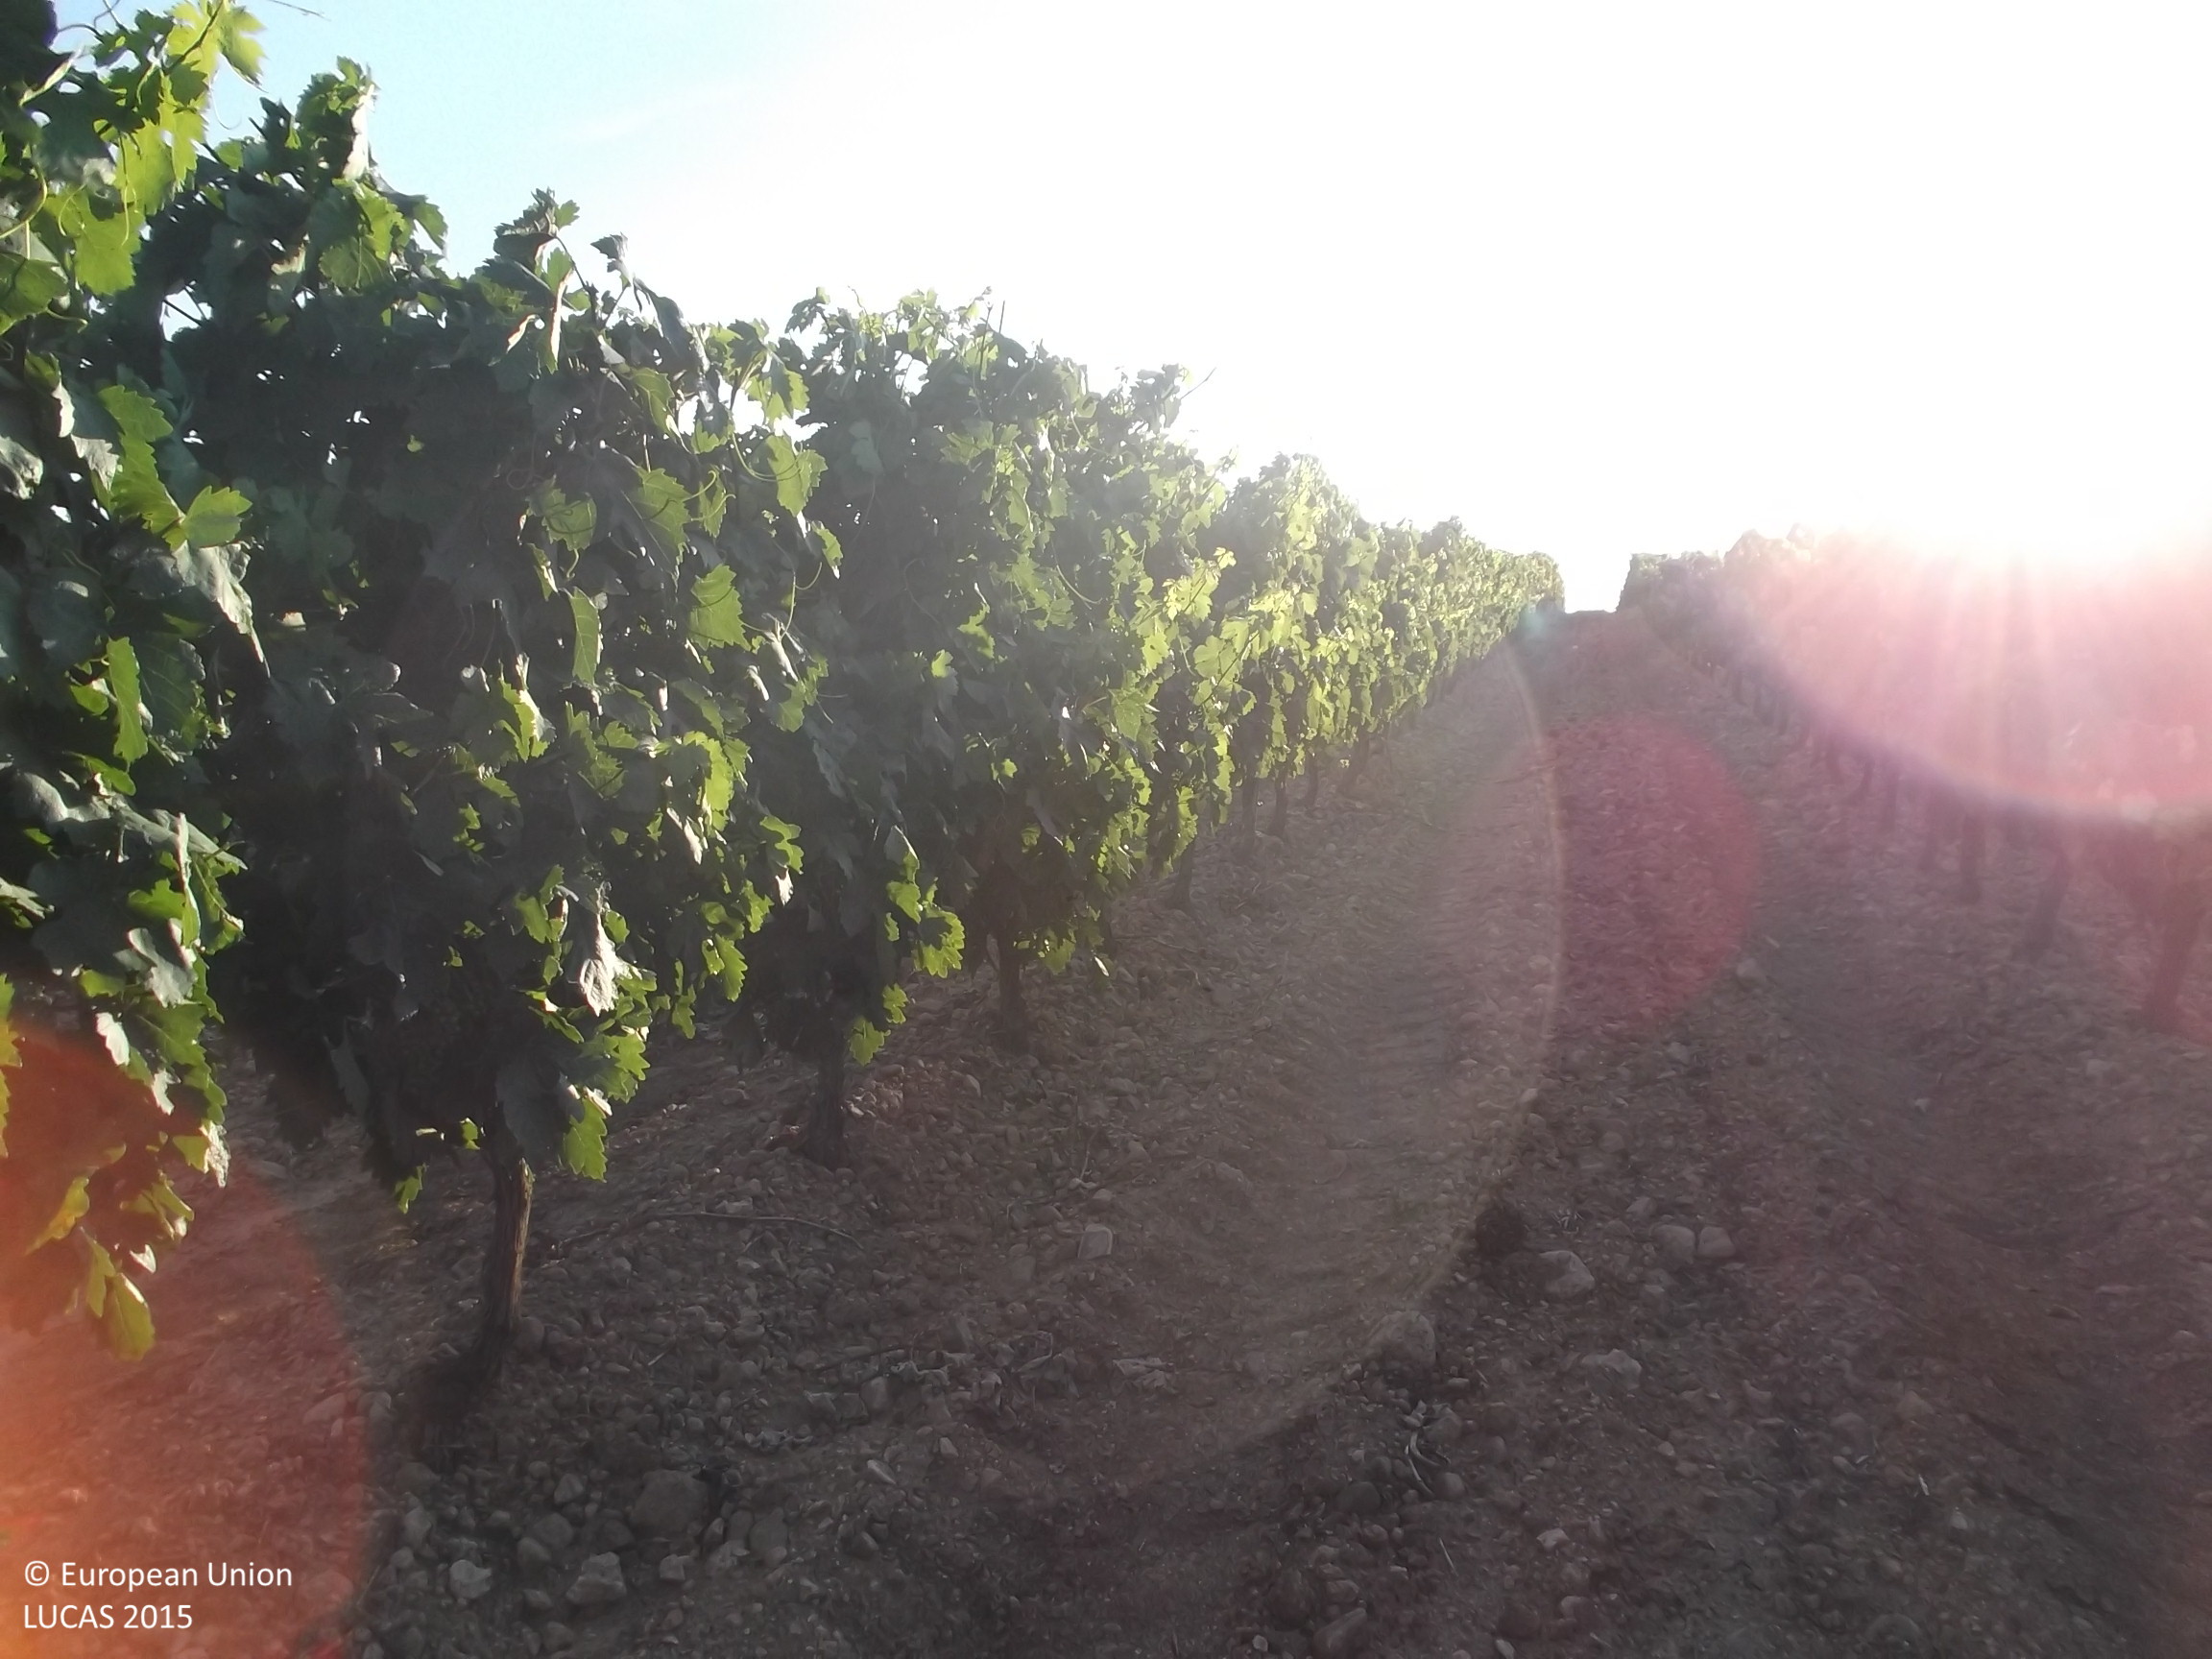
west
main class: Cropland
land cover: Vineyards
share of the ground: < 10 %
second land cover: Other bare soil
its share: > 75 %
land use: Agriculture (excluding fallow land and kitchen gardens)
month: June
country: ES
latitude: 42.3432
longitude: -2.1174
